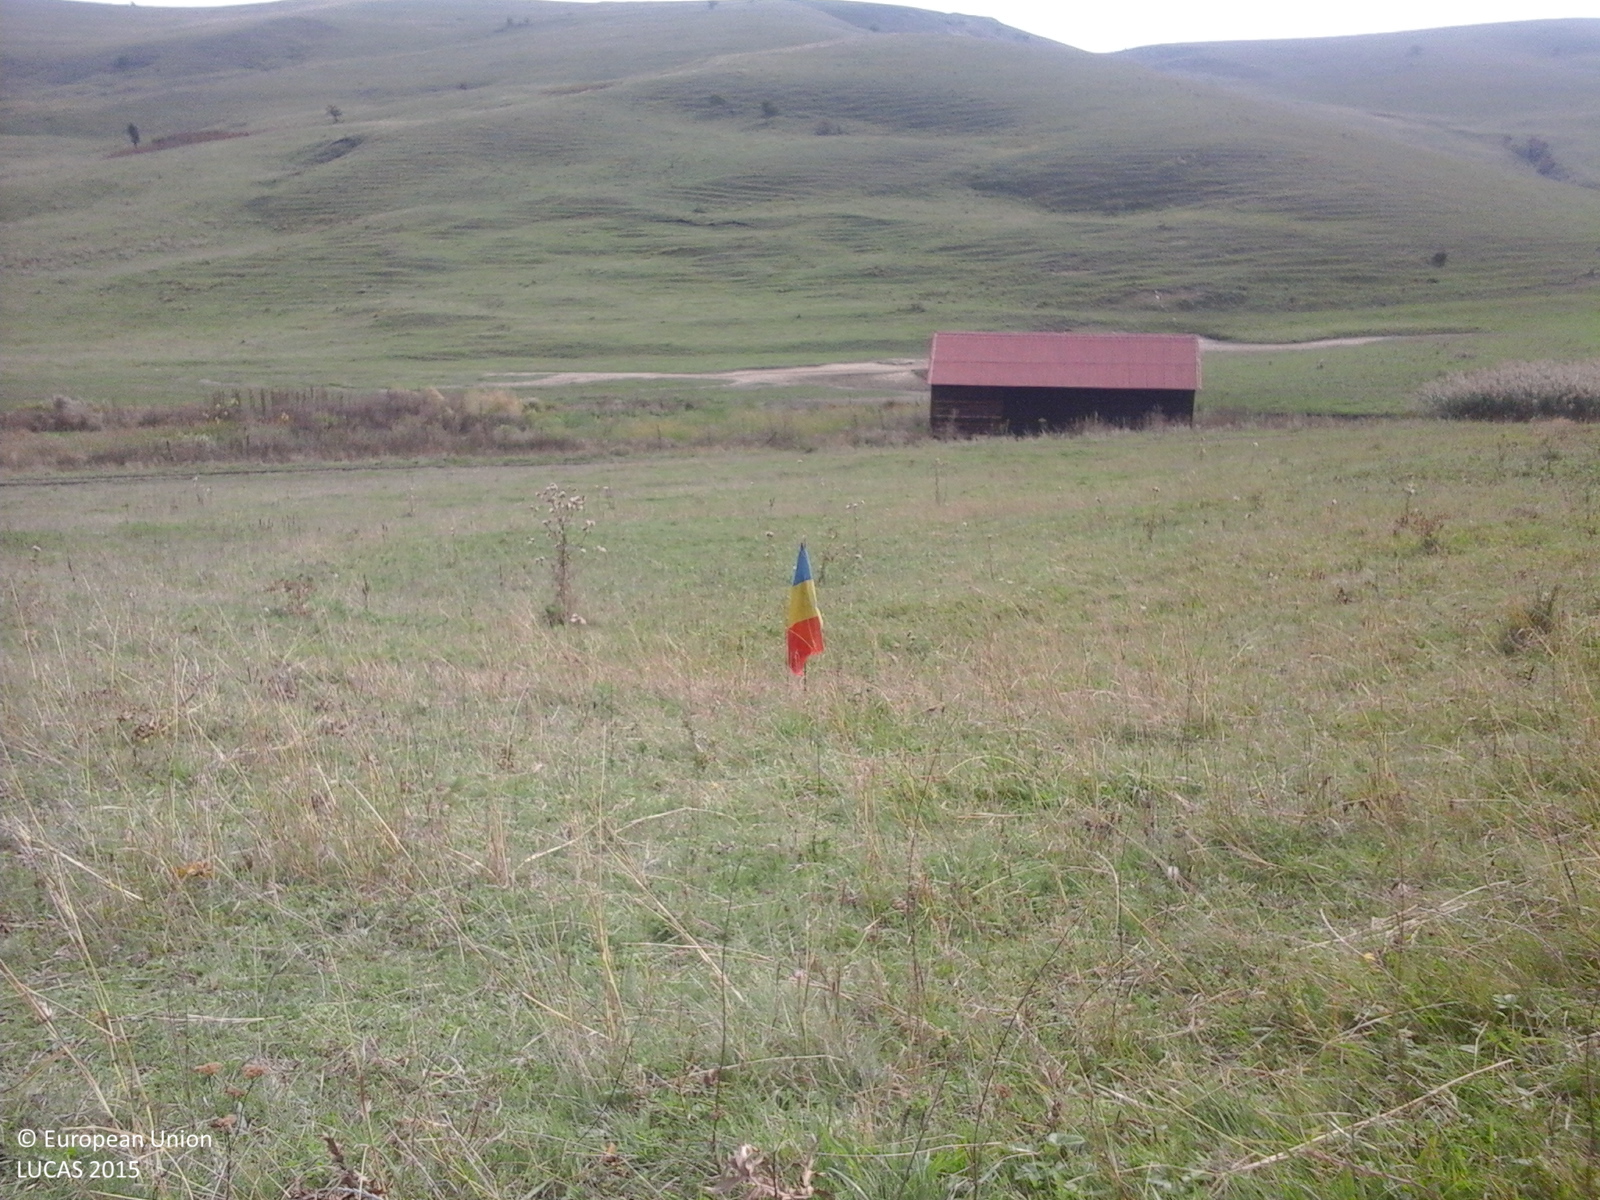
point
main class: Grassland
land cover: Grassland without tree/shrub cover
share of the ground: > 75 %
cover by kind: herbaceous plants 100 %
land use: Agriculture (excluding fallow land and kitchen gardens)
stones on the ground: < 10 %
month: September
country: RO
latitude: 46.7263
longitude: 23.8270
